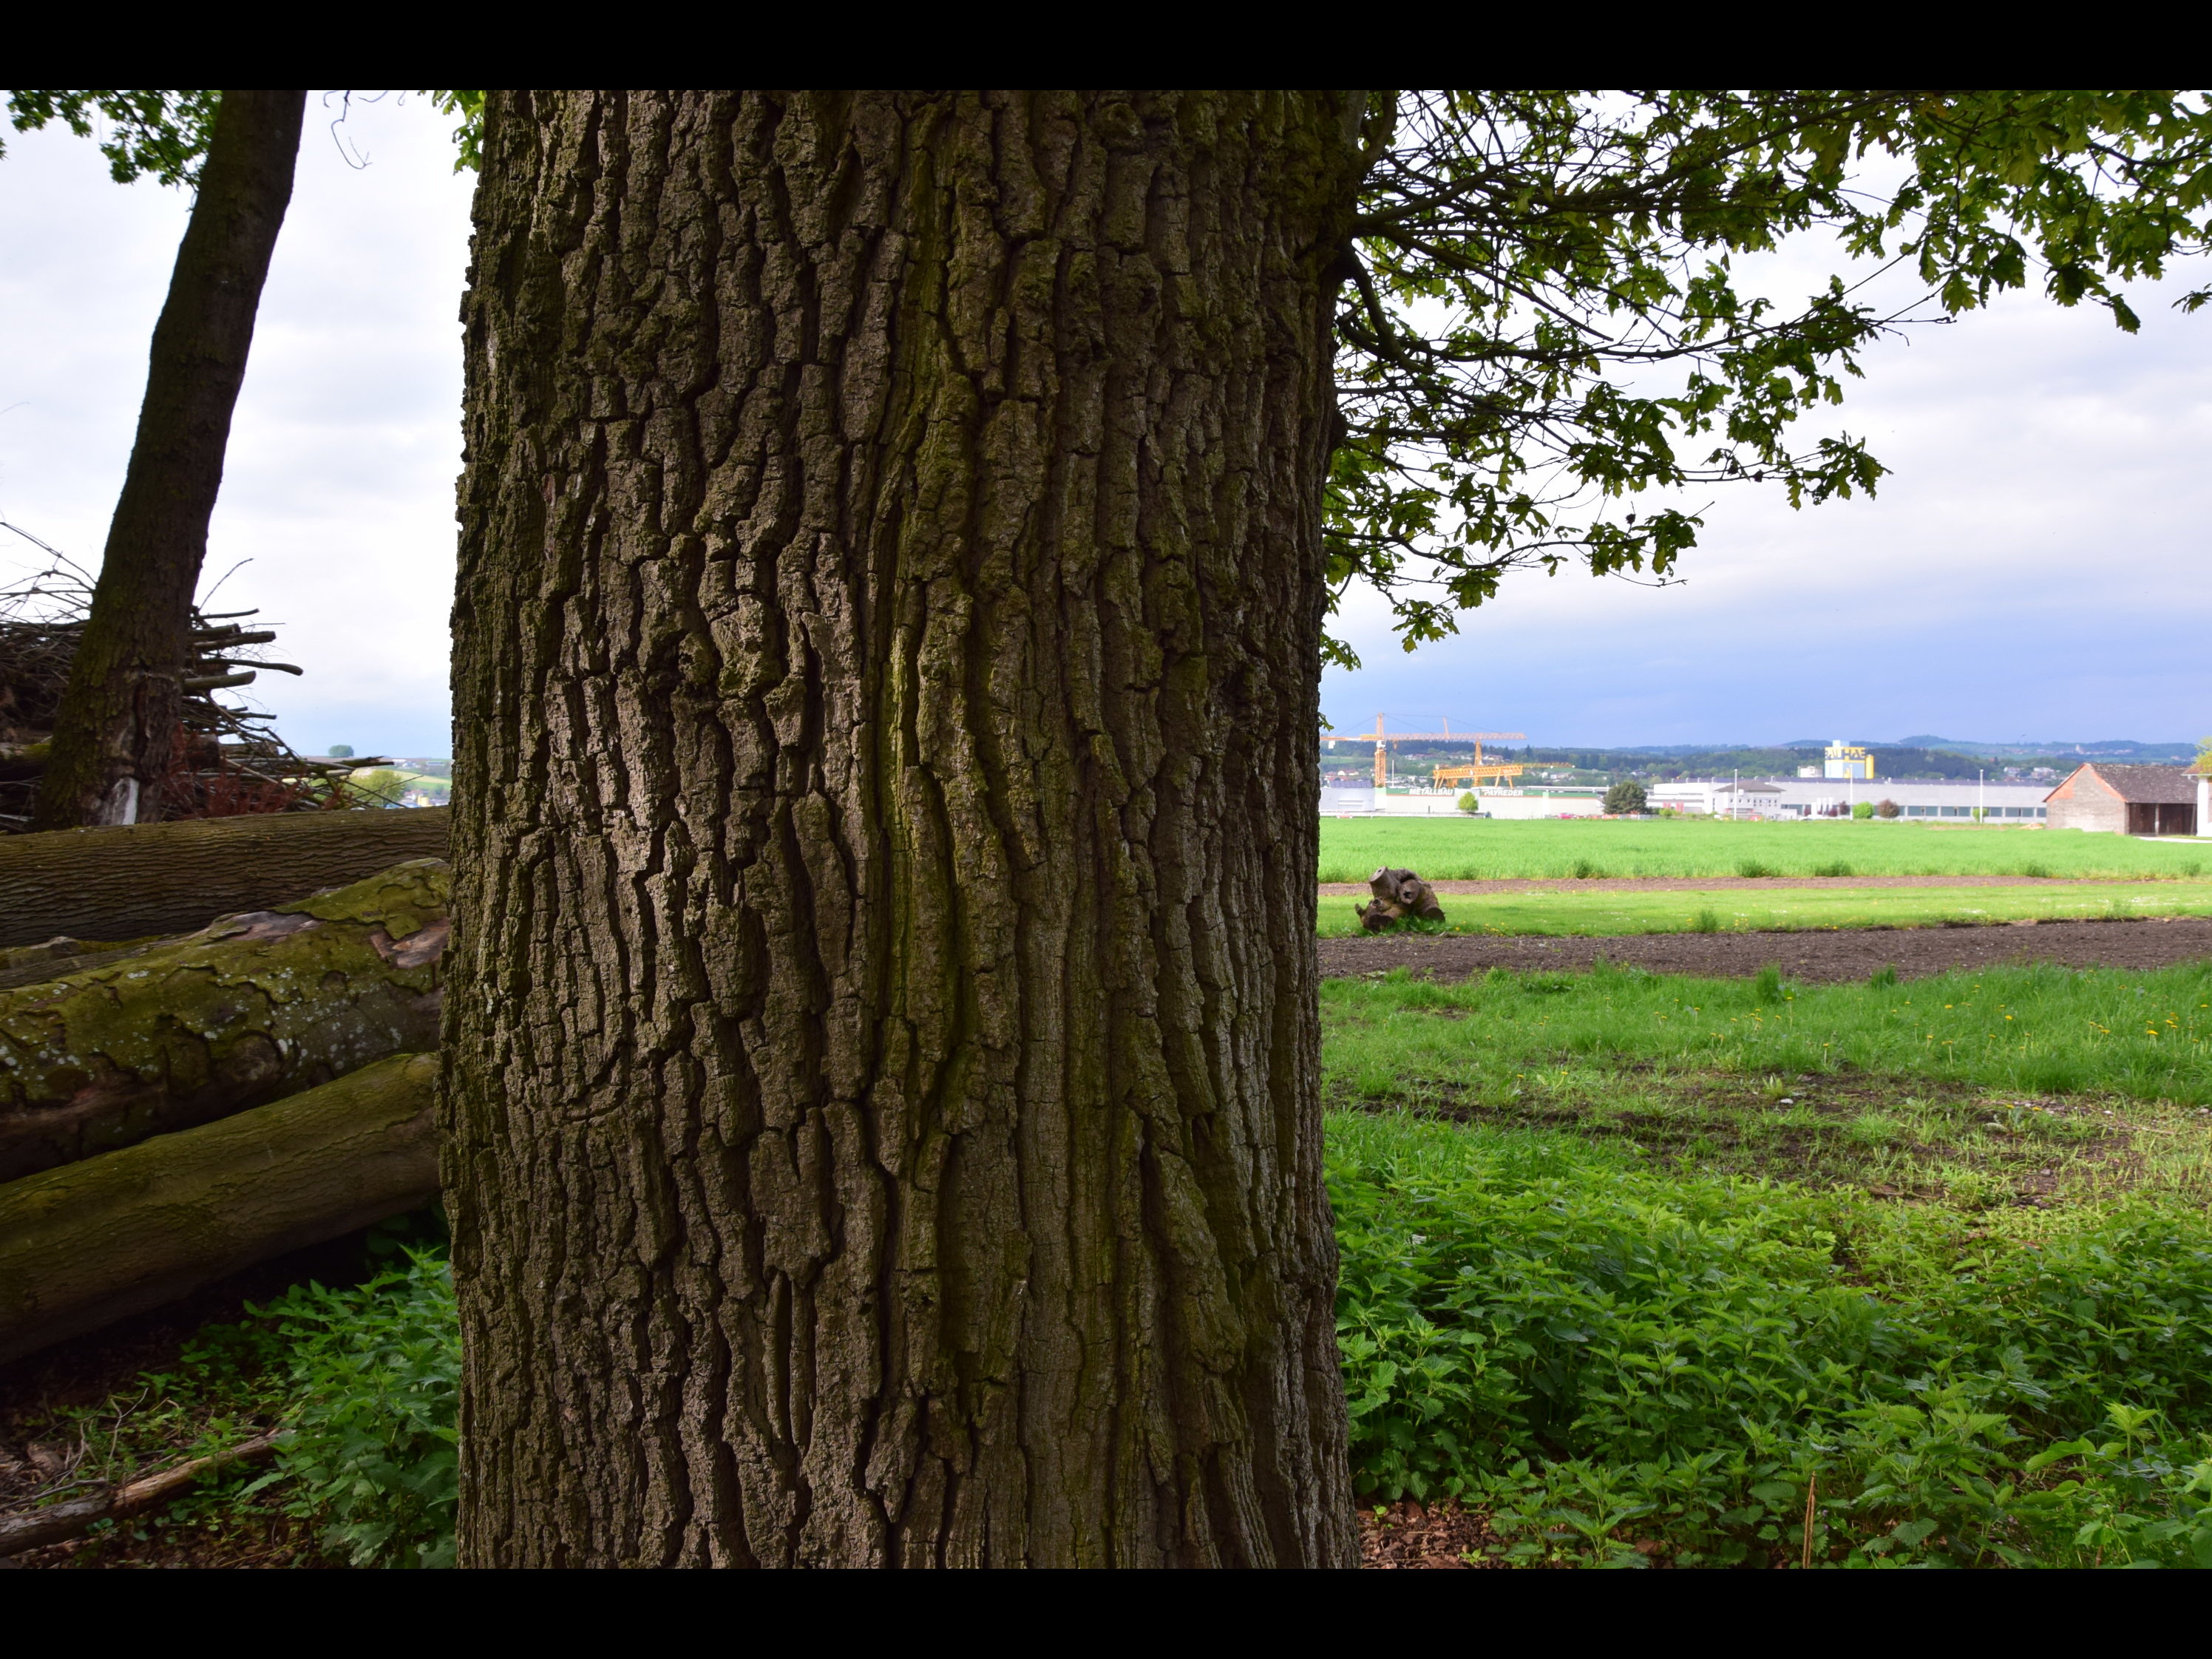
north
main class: Woodland
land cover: Broadleaved woodland
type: mesophytic deciduous forest
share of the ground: > 75 %
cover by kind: broadleaved forest trees 90 %, shrubs 5 %, herbaceous plants 5 %
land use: Forestry
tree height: > 5 m
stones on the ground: 10 - 25 %
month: May
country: AT
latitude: 48.2349
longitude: 14.6186
